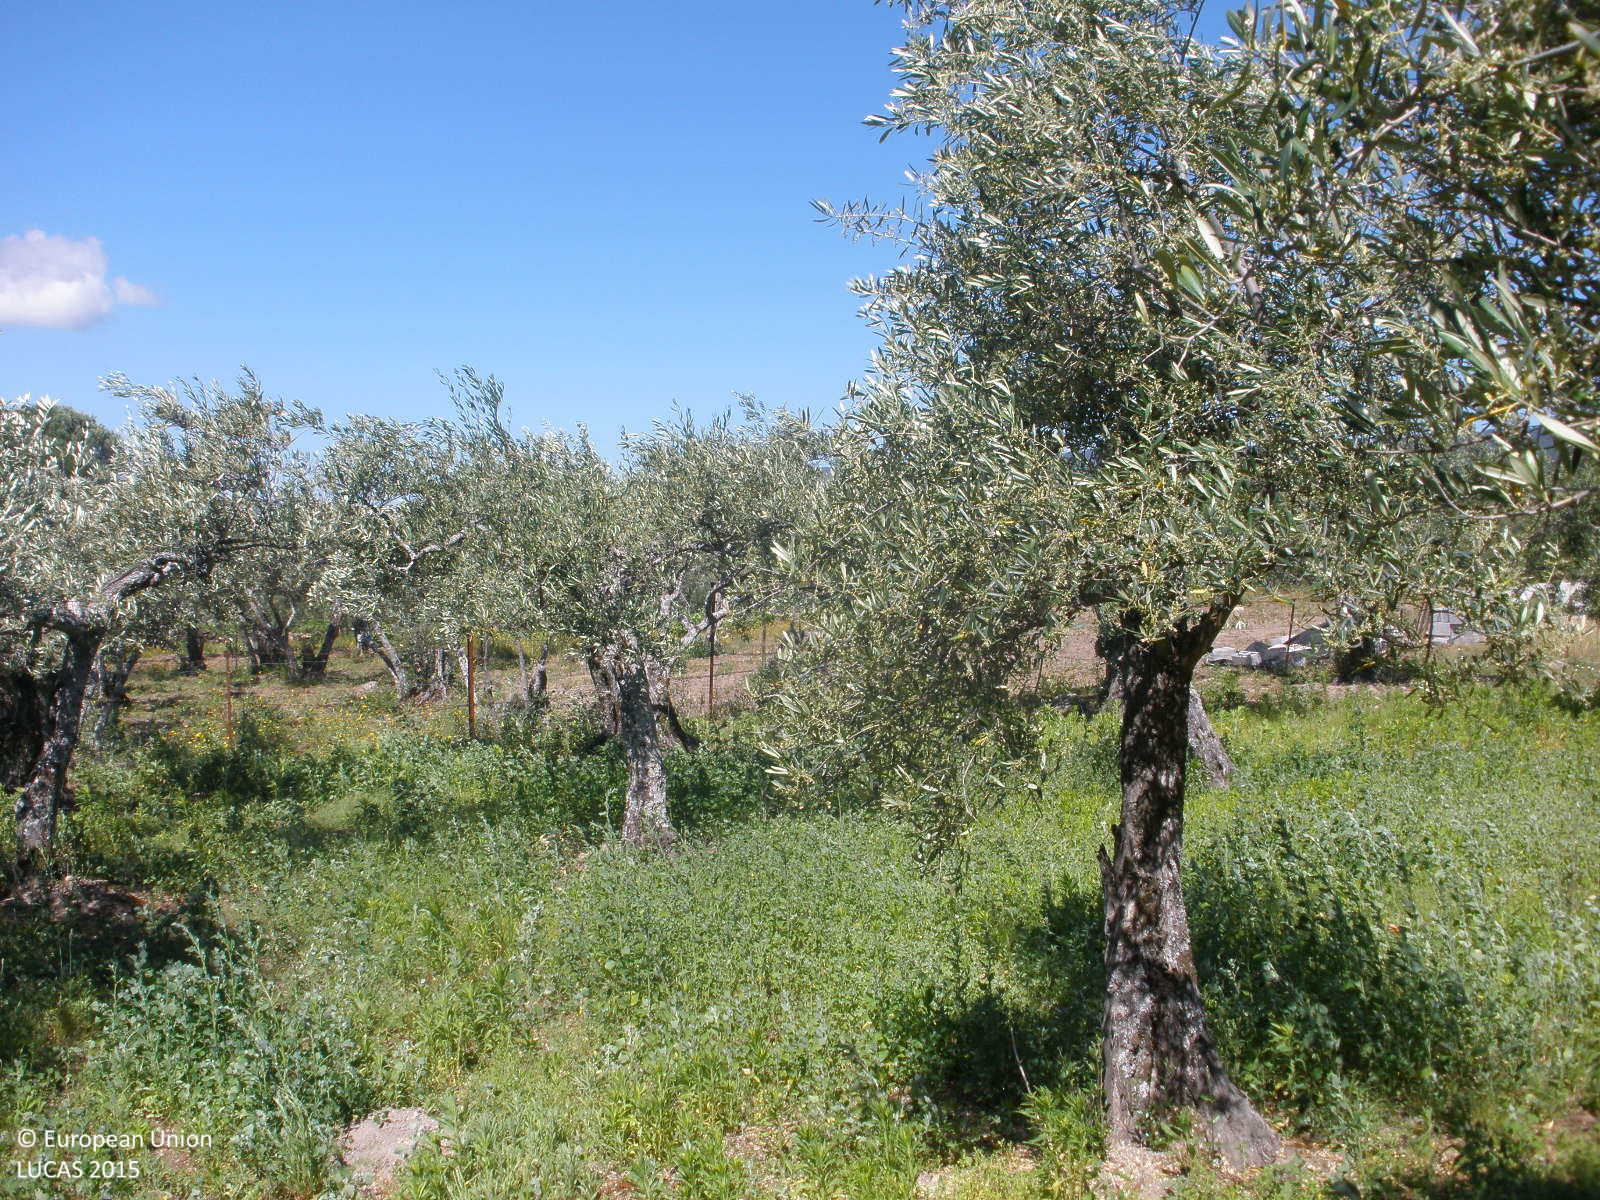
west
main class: Cropland
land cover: Olive groves
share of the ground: 50 - 75 %
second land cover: Spontaneously vegetated surfaces
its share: > 75 %
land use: Agriculture (excluding fallow land and kitchen gardens)
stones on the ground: < 10 %
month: May
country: ES
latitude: 40.2159
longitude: -6.8586
